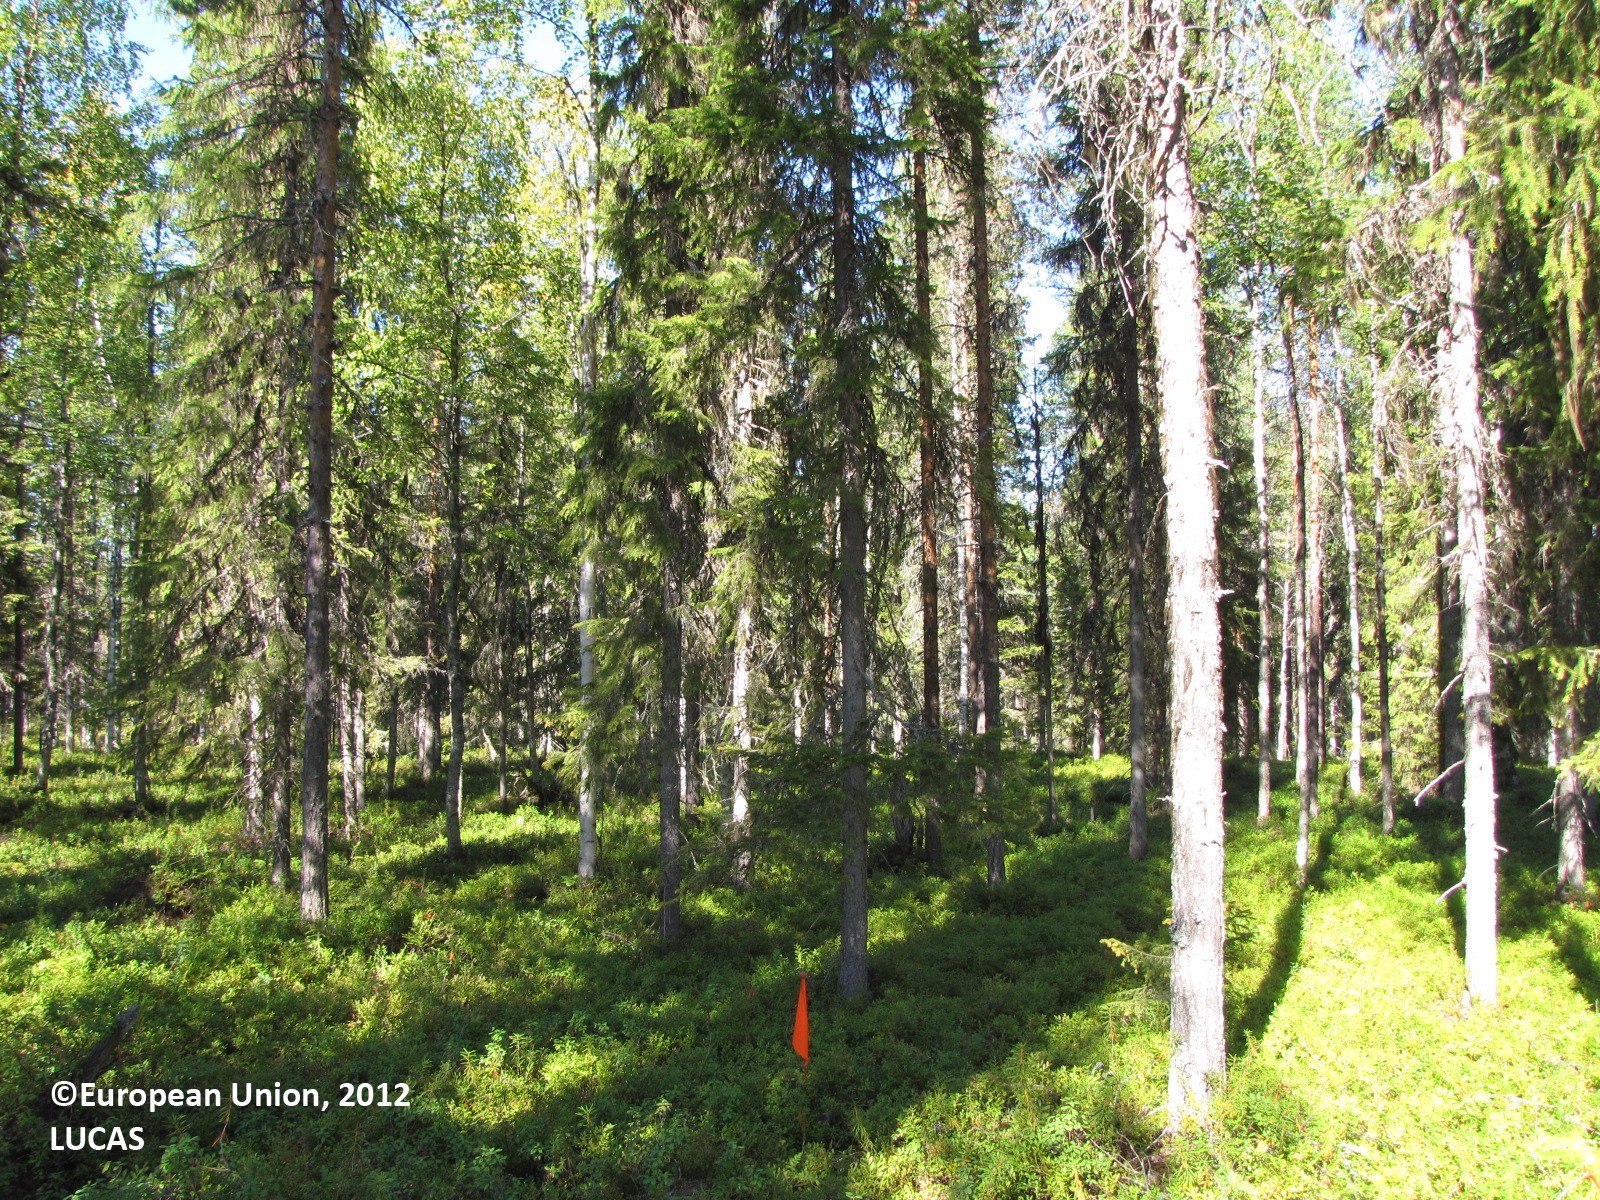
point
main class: Woodland
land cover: Other coniferous woodland
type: boreal forest
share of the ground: 50 - 75 %
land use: Forestry
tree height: > 5 m
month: August
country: FI
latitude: 66.9329
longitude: 25.2157
